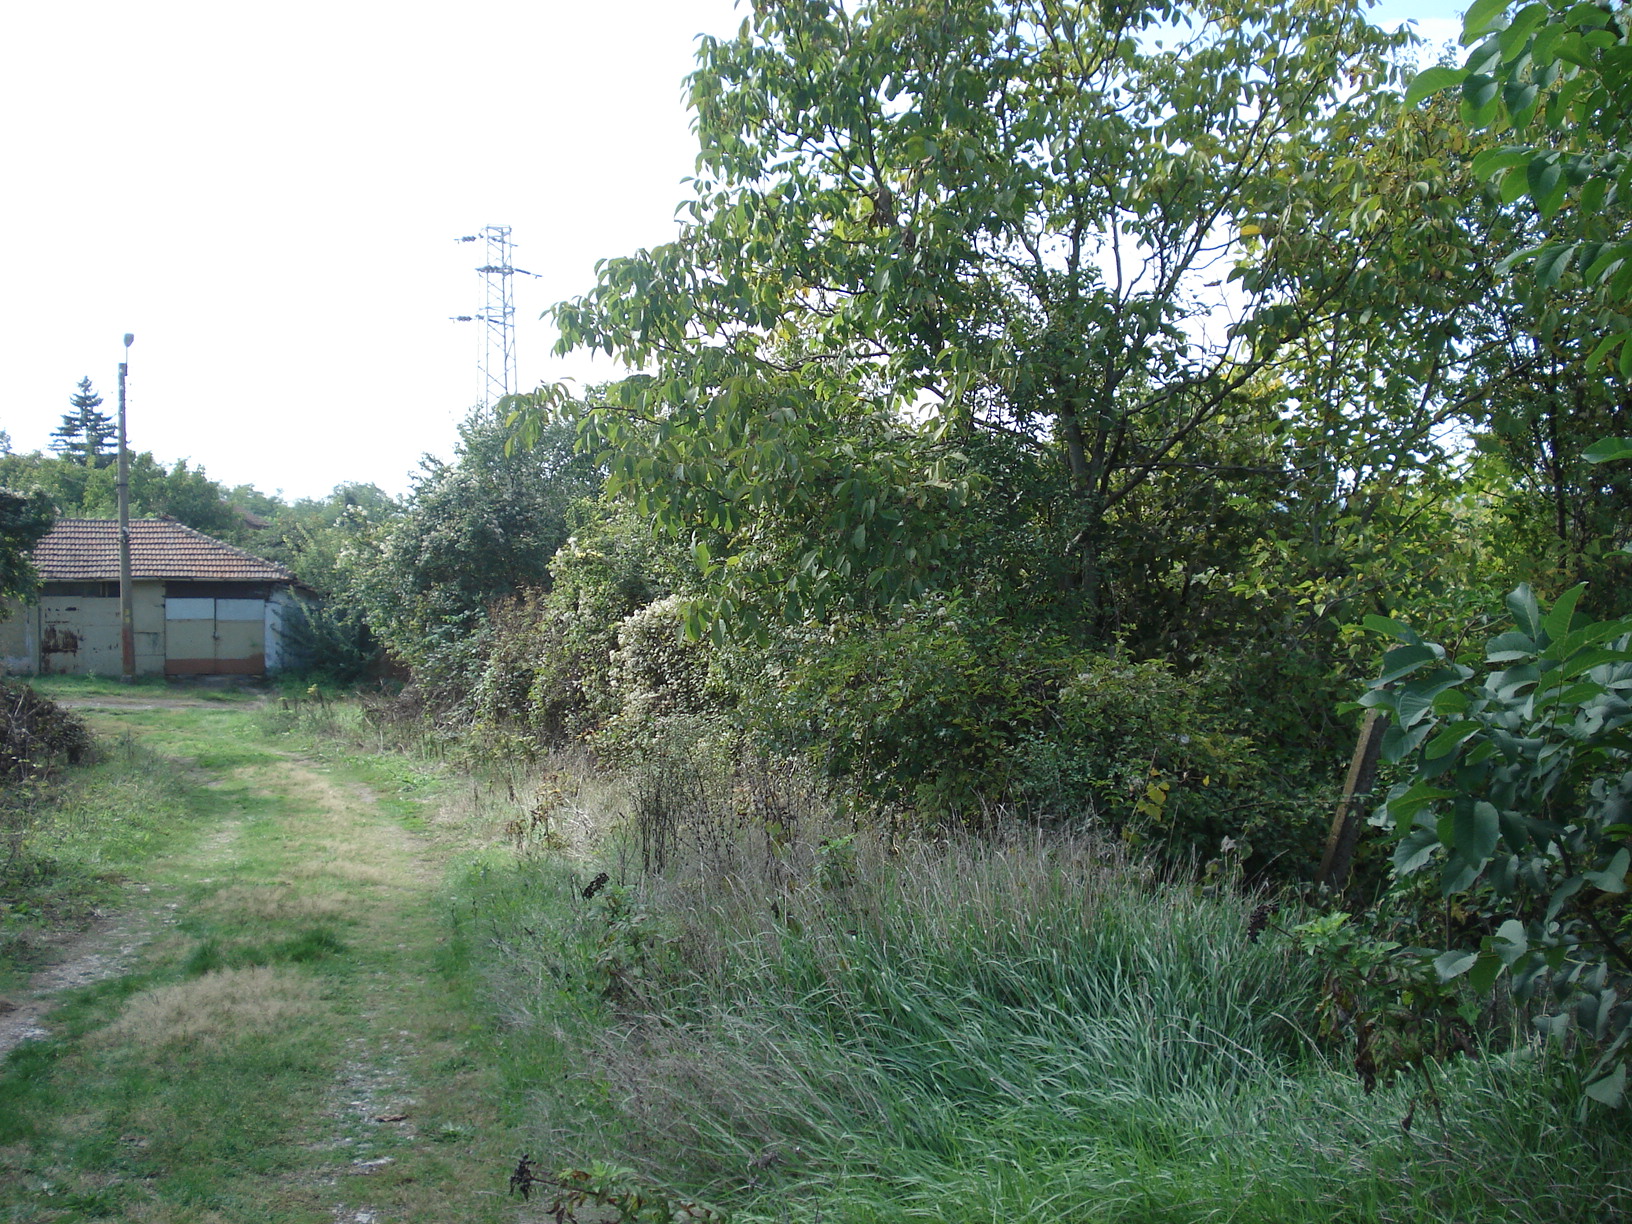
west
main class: Grassland
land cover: Grassland without tree/shrub cover
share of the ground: > 75 %
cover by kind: herbaceous plants 100 %
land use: Residential
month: October
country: BG
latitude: 43.1912
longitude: 25.9994
